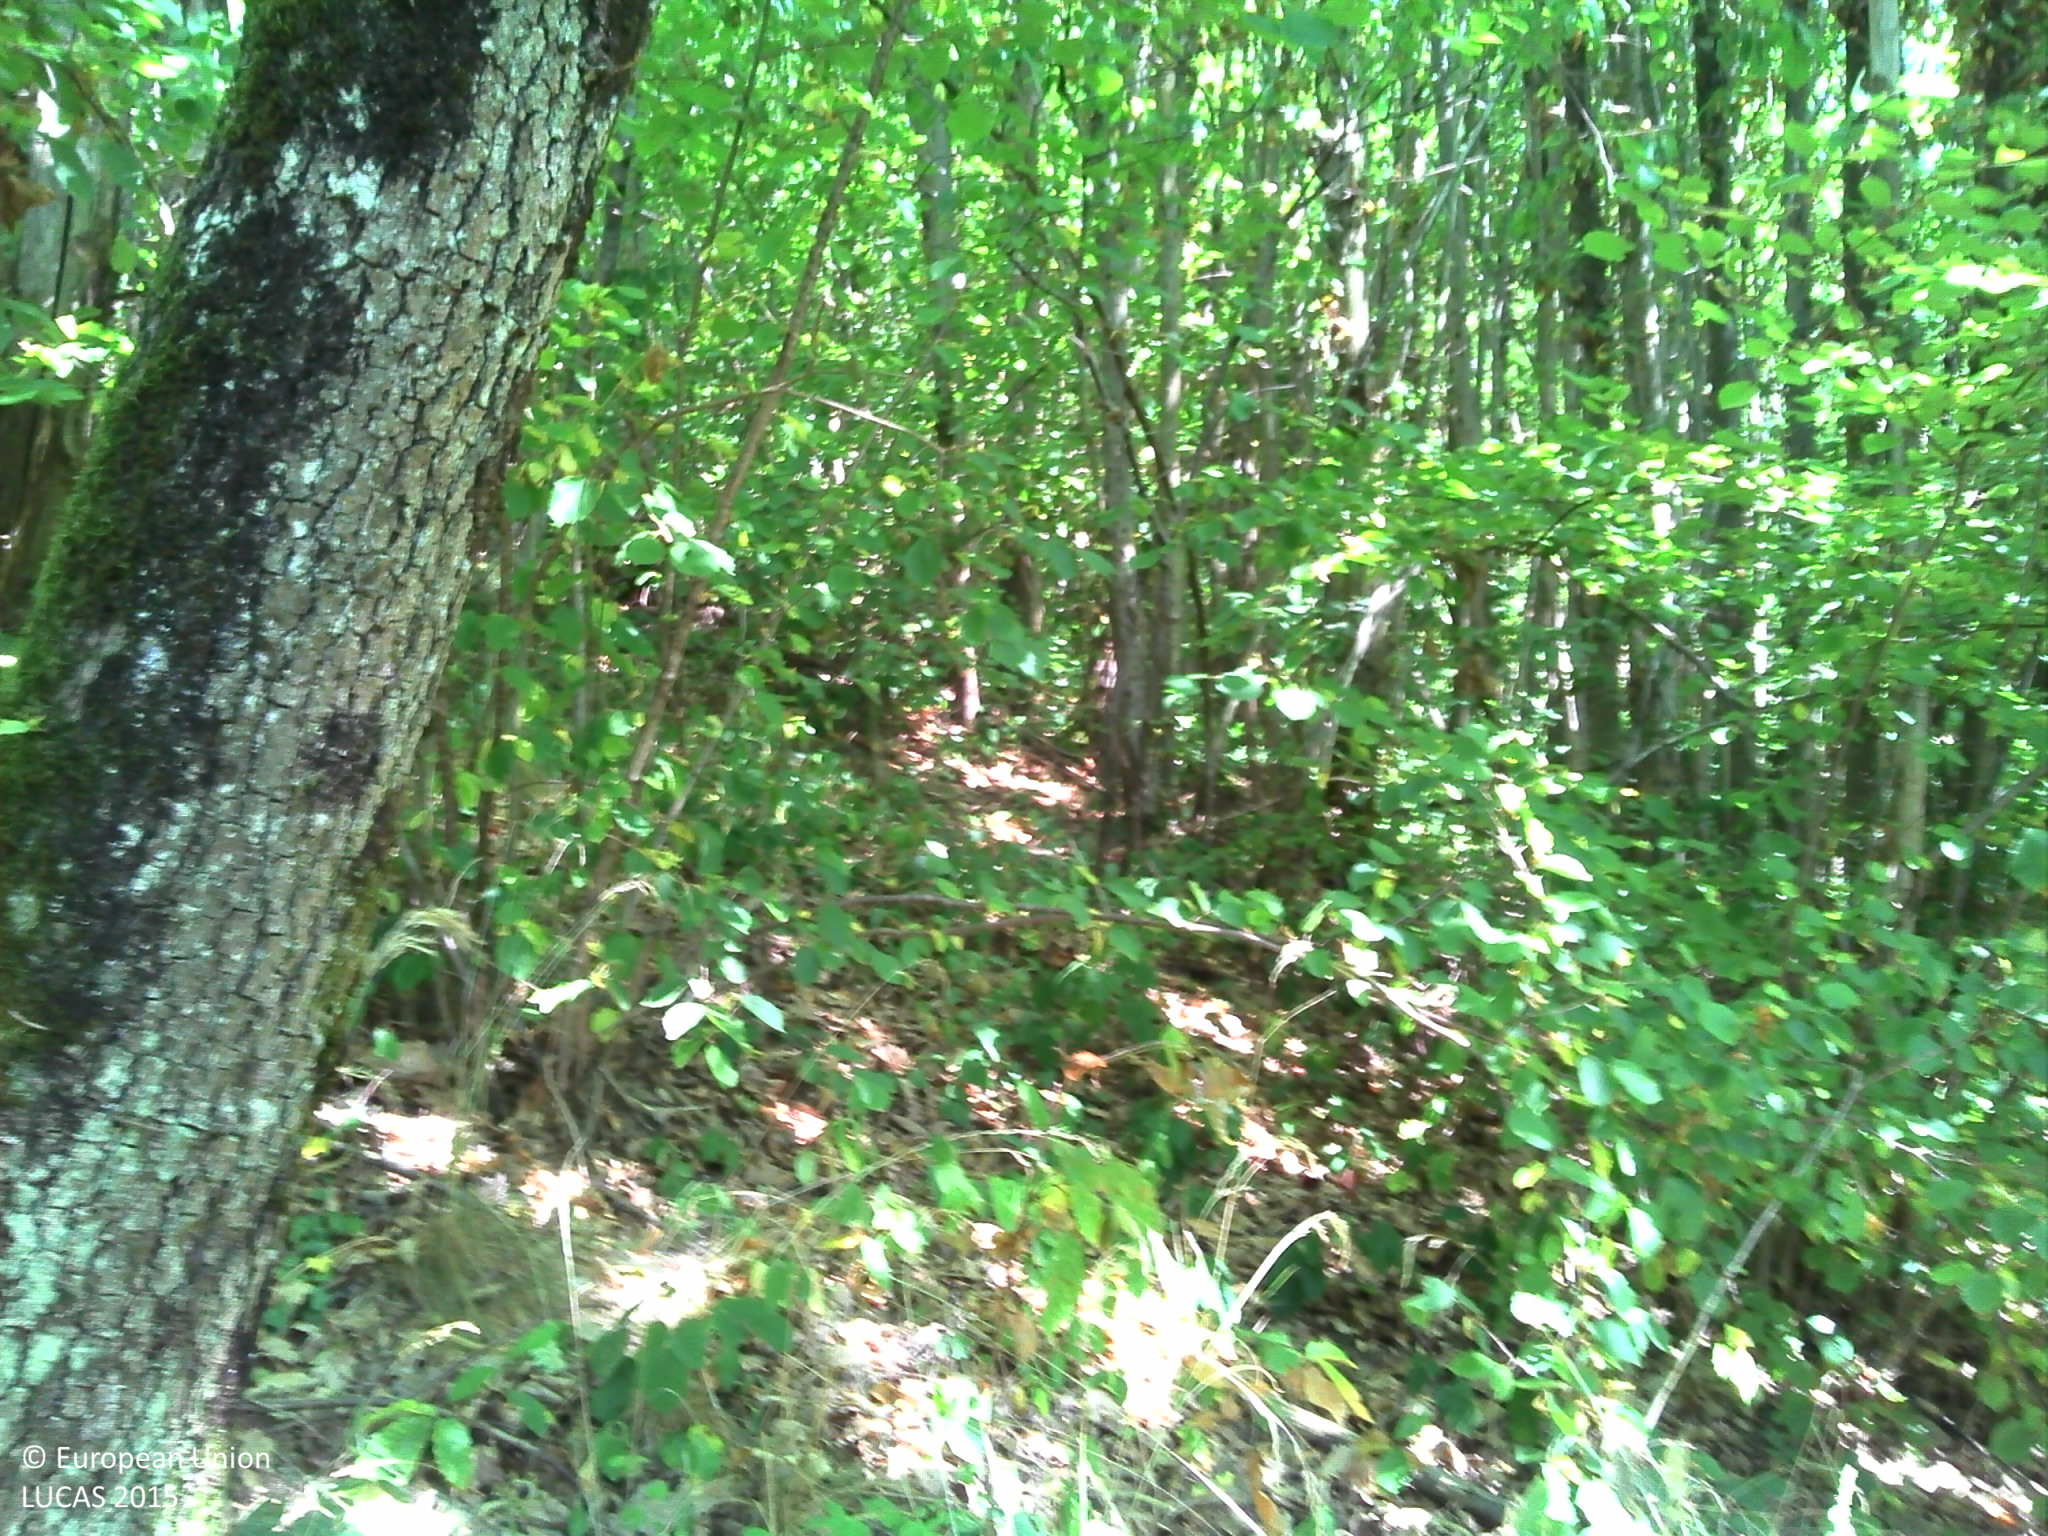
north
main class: Woodland
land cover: Broadleaved woodland
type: mesophytic deciduous forest
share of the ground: > 75 %
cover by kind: broadleaved forest trees 90 %, herbaceous plants 5 %, unconsolidated bare surface 5 %
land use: Forestry
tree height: > 5 m
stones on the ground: 10 - 25 %
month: July
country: FR
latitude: 45.3173
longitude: 5.4765
